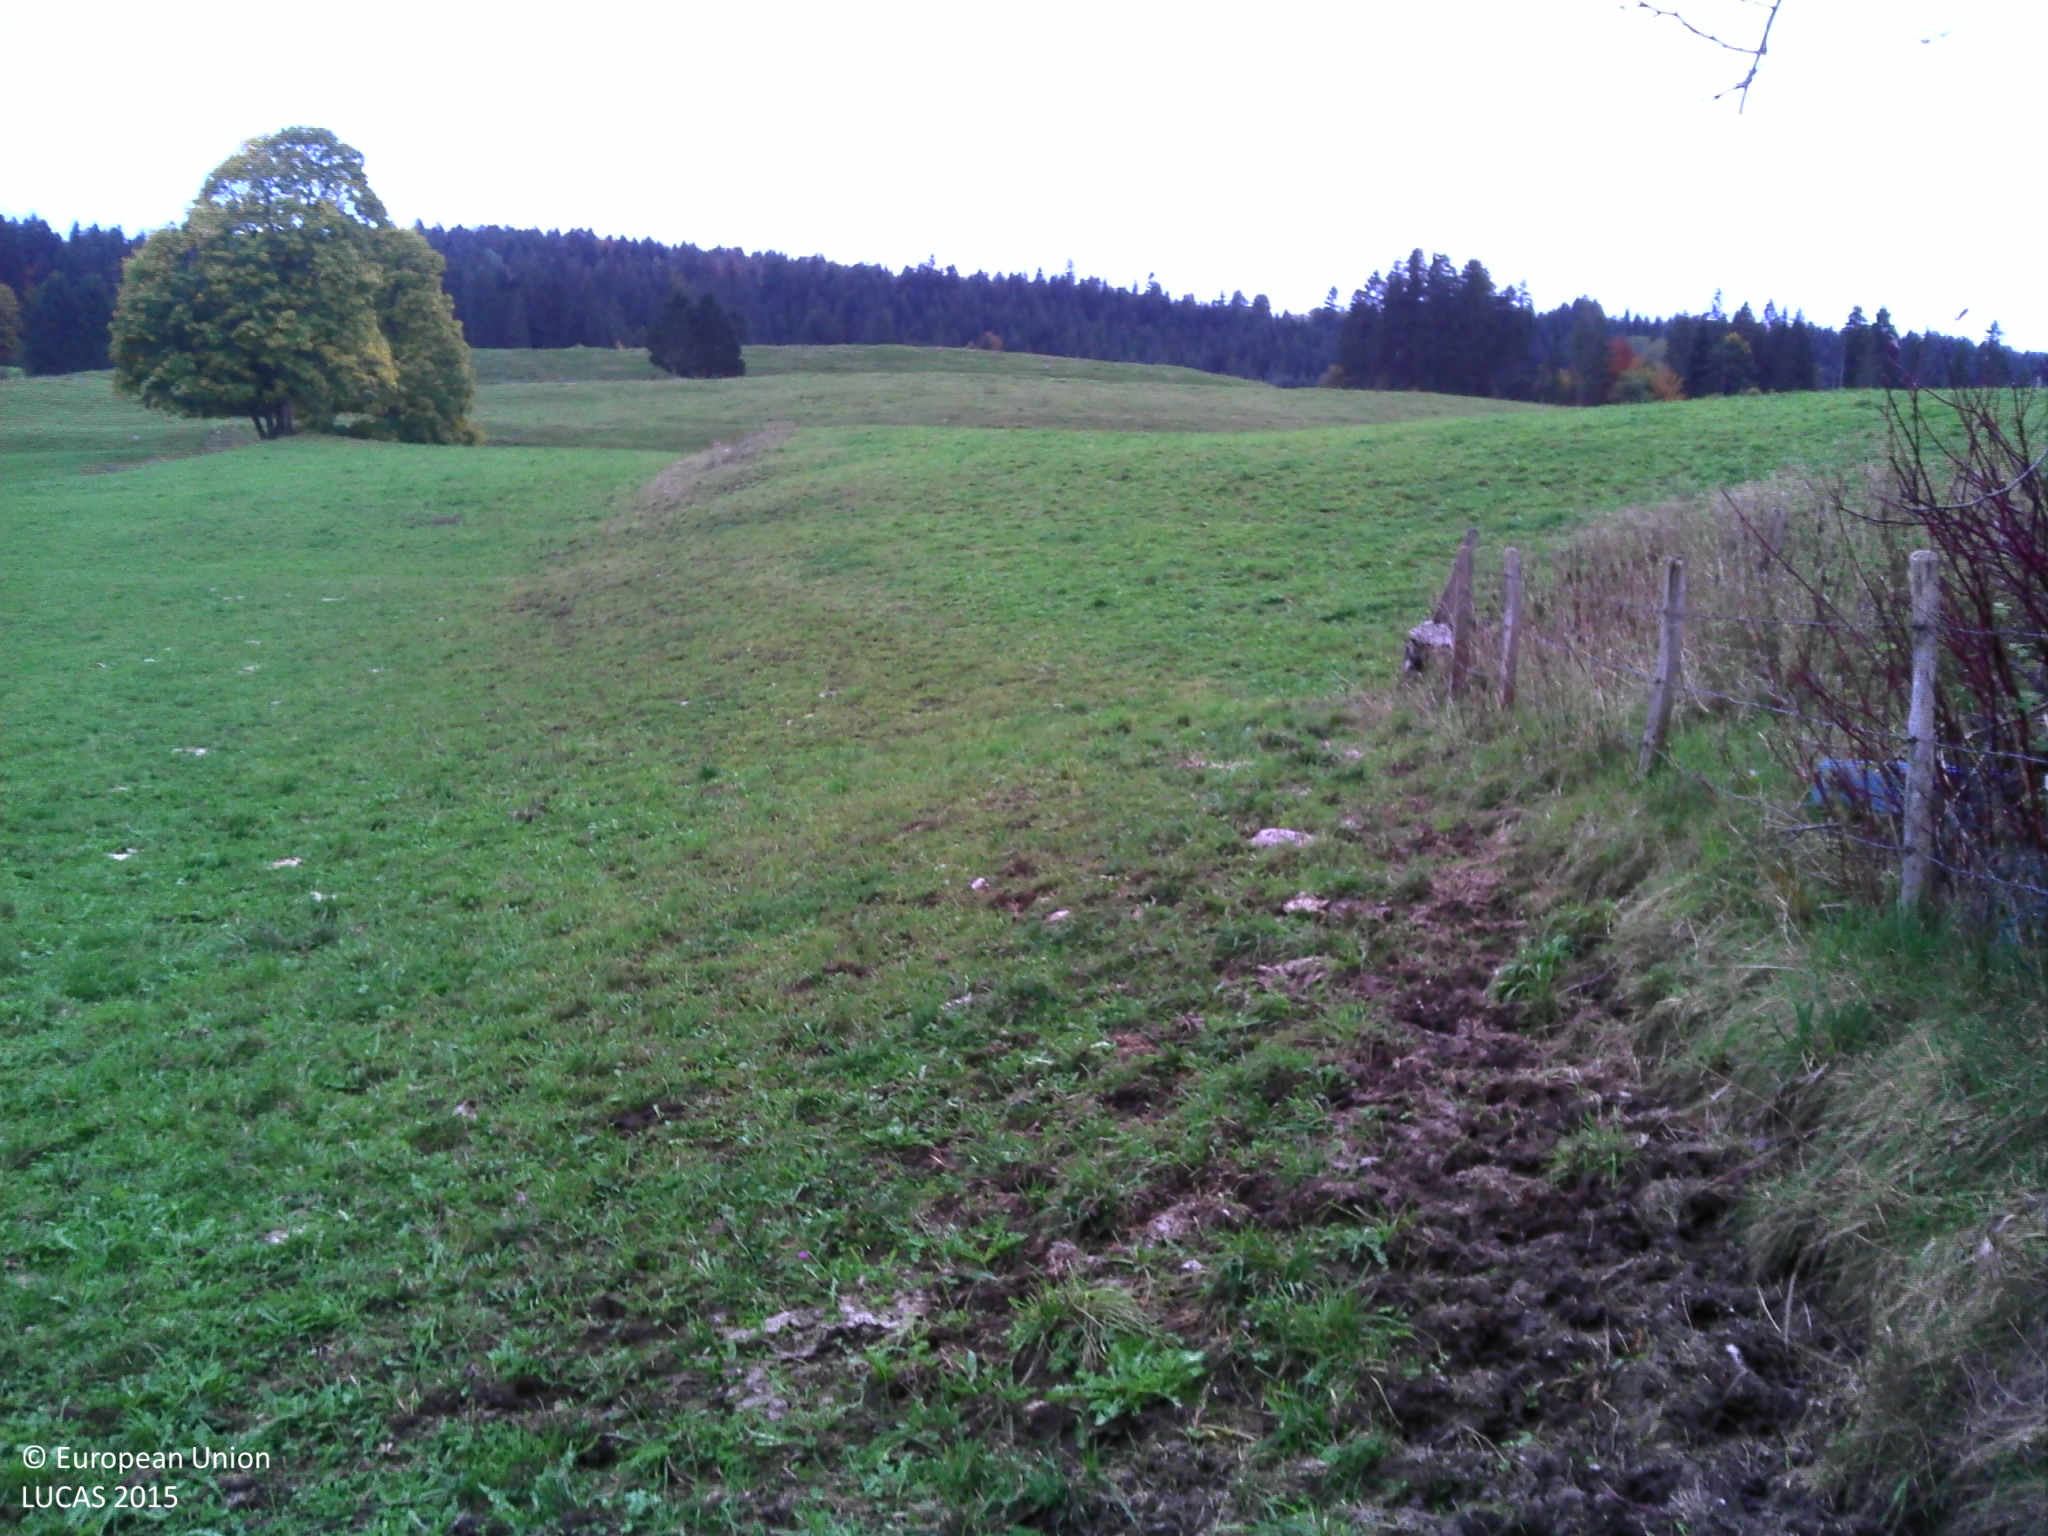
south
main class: Grassland
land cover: Grassland without tree/shrub cover
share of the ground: > 75 %
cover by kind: herbaceous plants 100 %
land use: Agriculture (excluding fallow land and kitchen gardens)
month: October
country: FR
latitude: 46.7370
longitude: 6.2728
